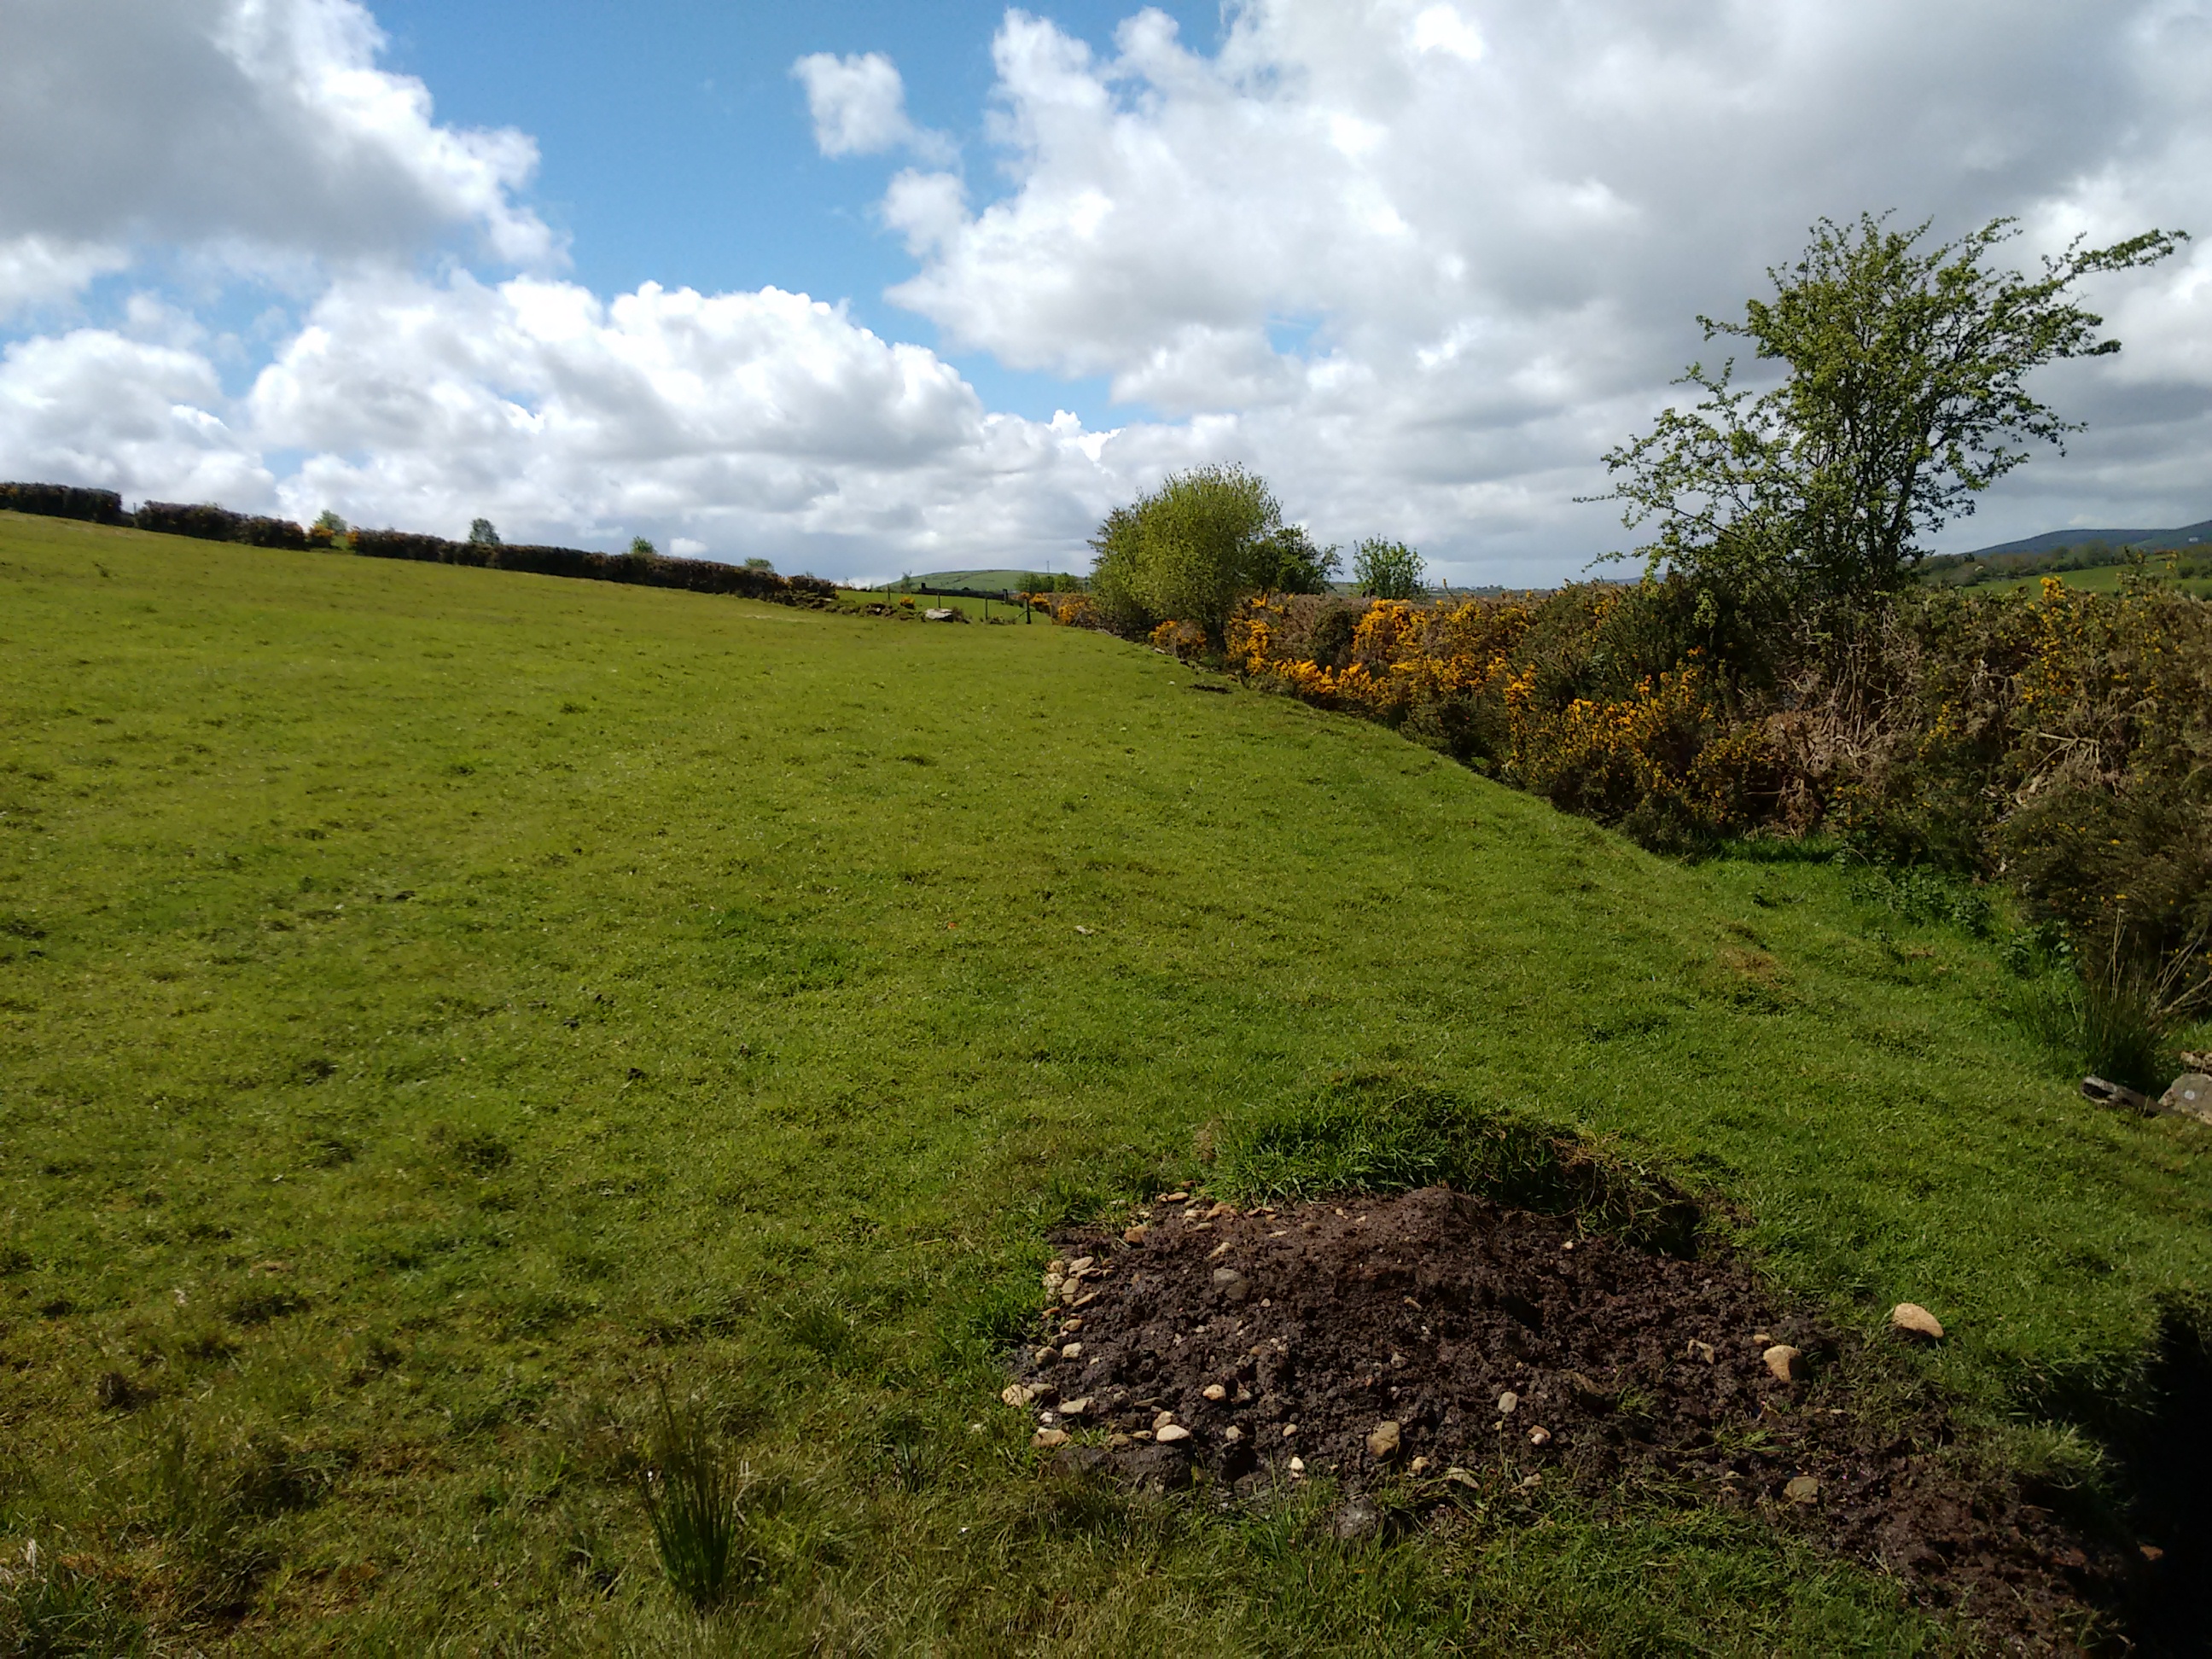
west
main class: Grassland
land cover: Grassland without tree/shrub cover
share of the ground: > 75 %
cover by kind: herbaceous plants 100 %
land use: Agriculture (excluding fallow land and kitchen gardens)
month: May
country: GB
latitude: 54.9246
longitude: -7.0382
